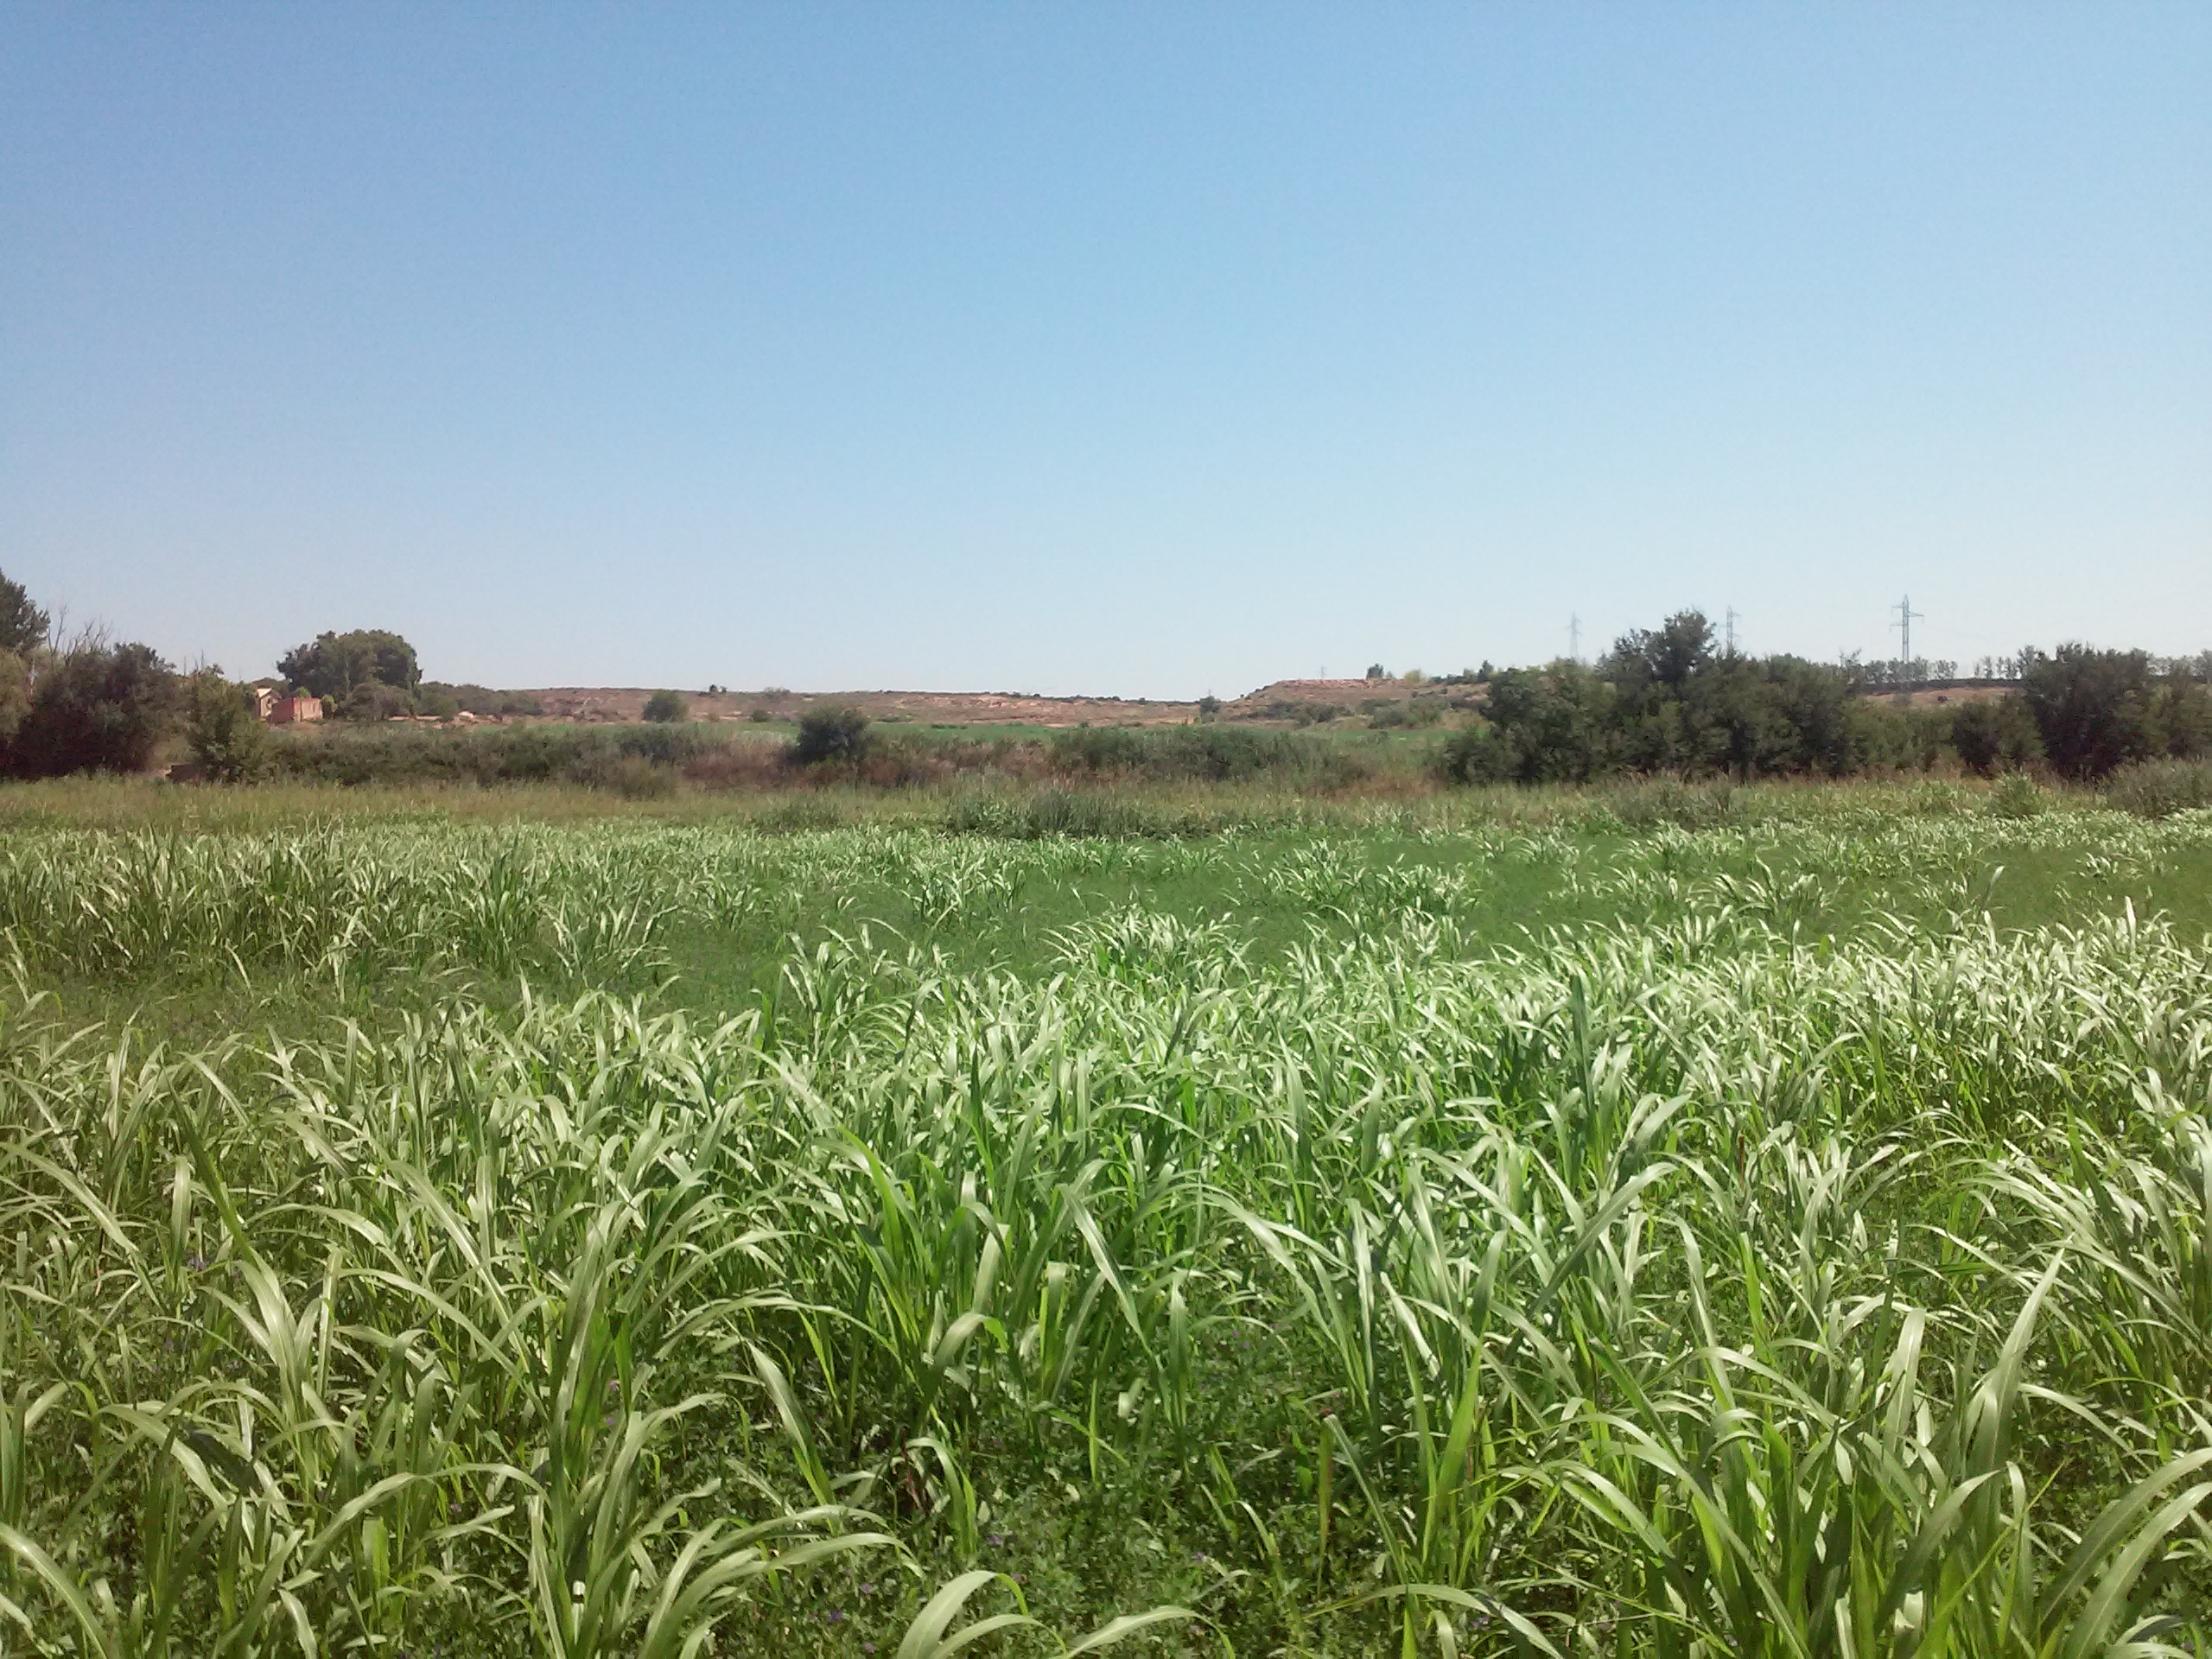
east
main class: Cropland
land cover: Lucerne
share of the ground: 50 - 75 %
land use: Agriculture (excluding fallow land and kitchen gardens)
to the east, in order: Lucerne; Grass margins; Lucerne; Shrubland with sparse tree cover; Ditches and canals; Shruby margins; Lucerne
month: July
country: ES
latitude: 41.7117
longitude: 0.6485
